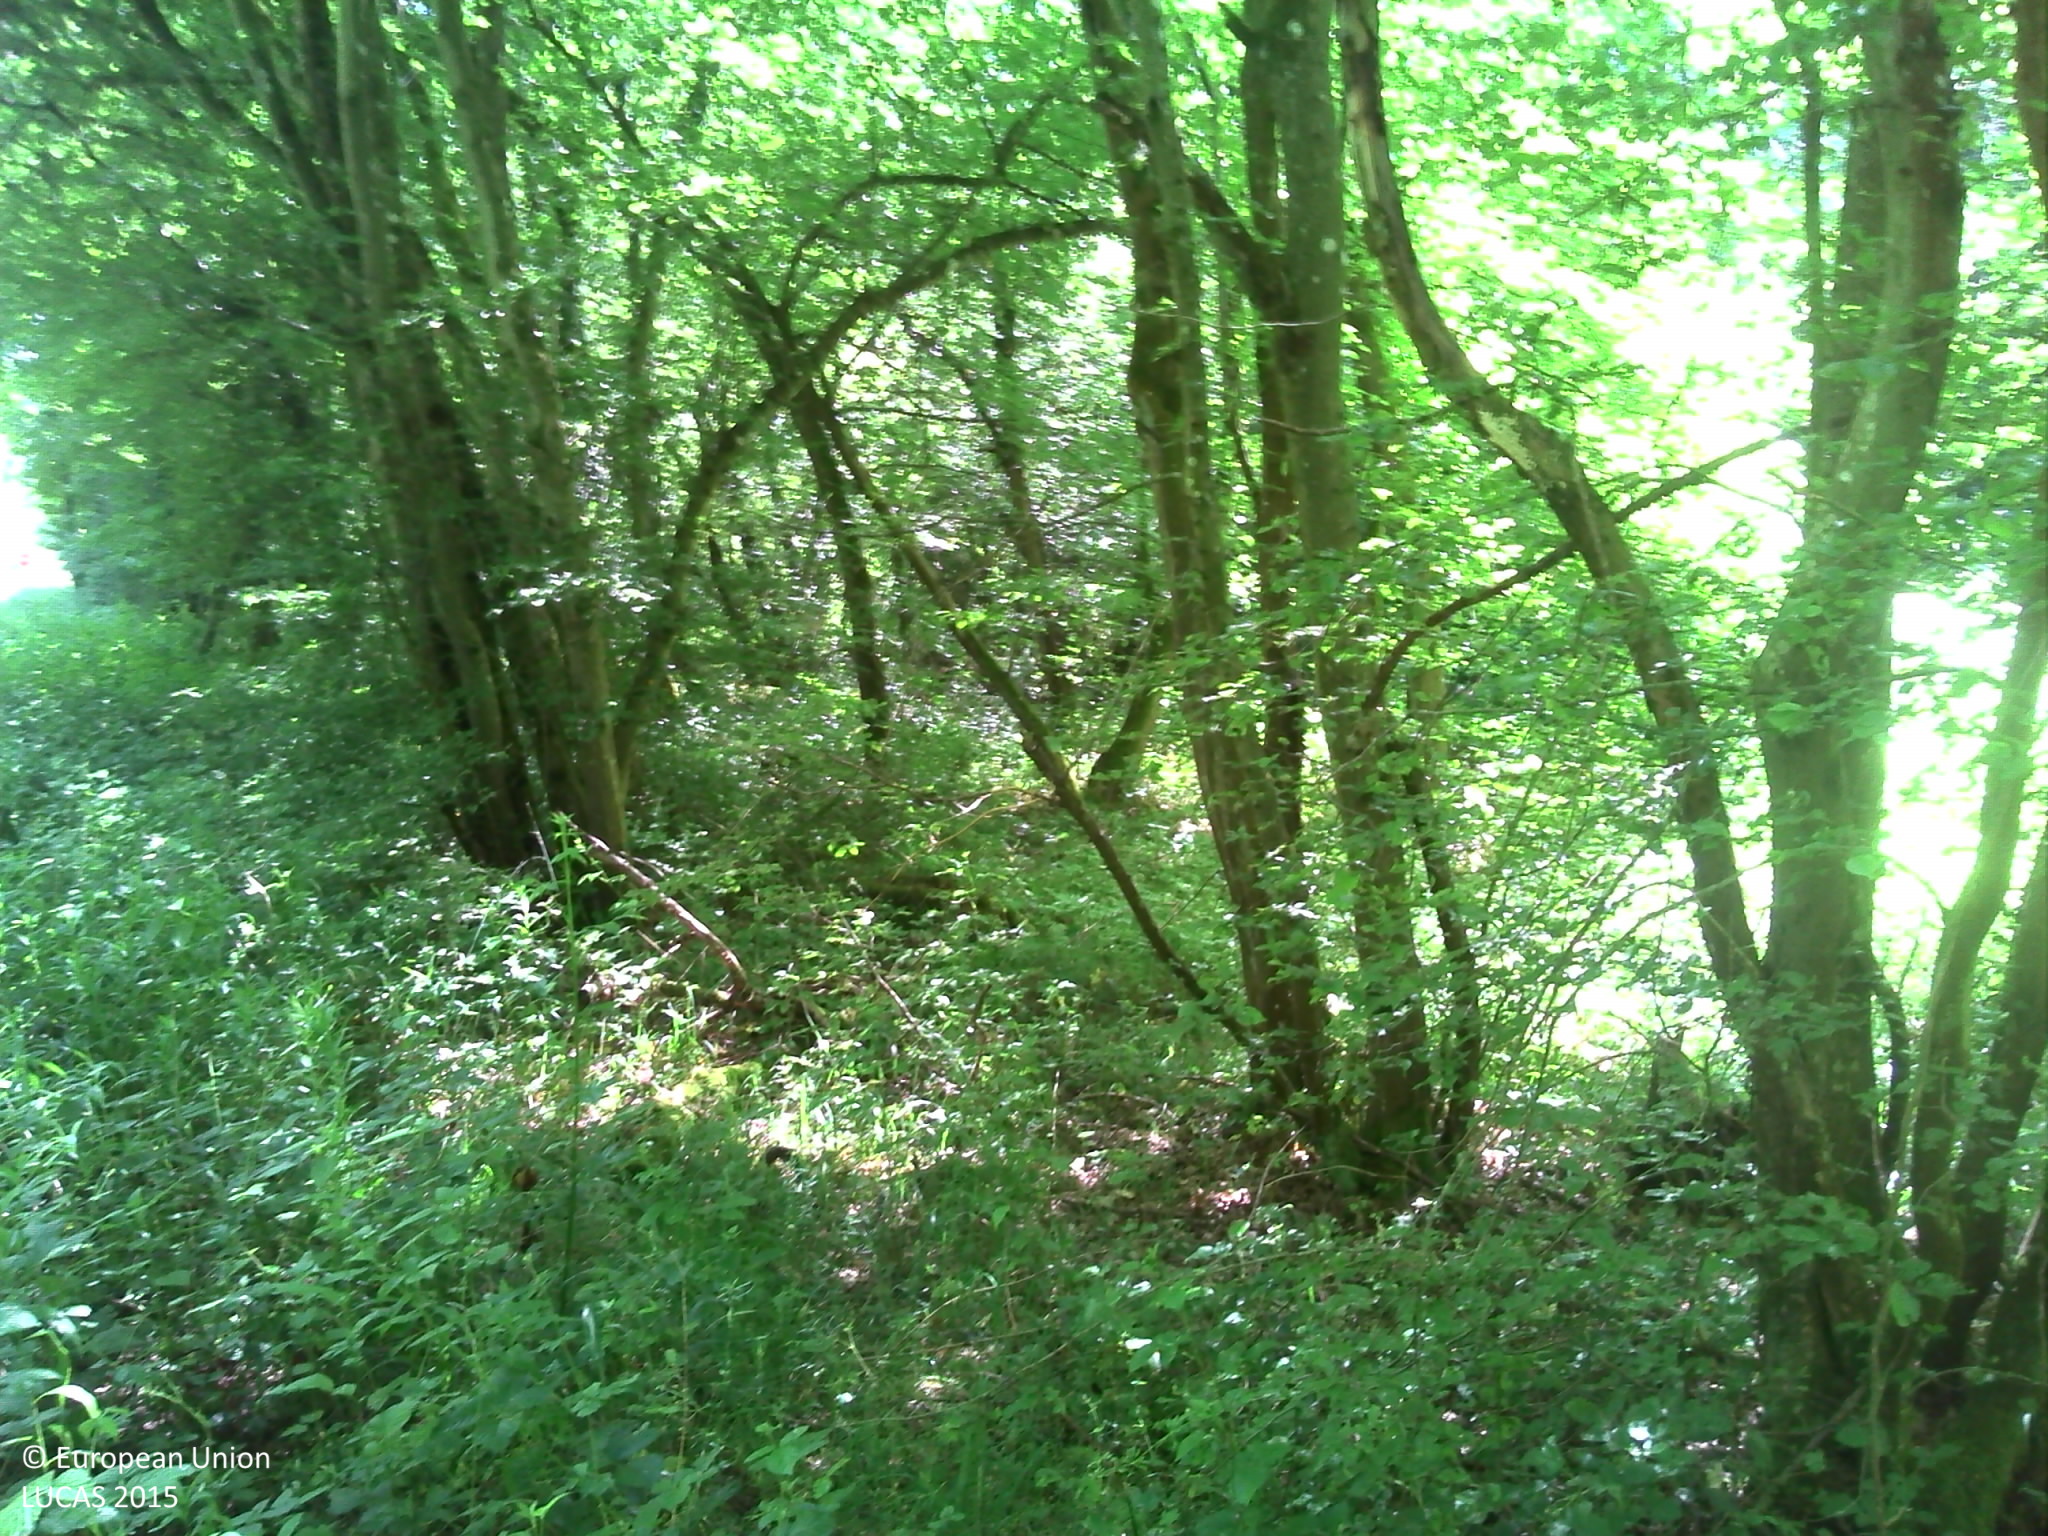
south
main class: Woodland
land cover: Broadleaved woodland
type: mesophytic deciduous forest
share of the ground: > 75 %
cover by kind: broadleaved forest trees 90 %, herbaceous plants 10 %
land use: Forestry
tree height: > 5 m
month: June
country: FR
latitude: 47.6727
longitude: 7.4843
